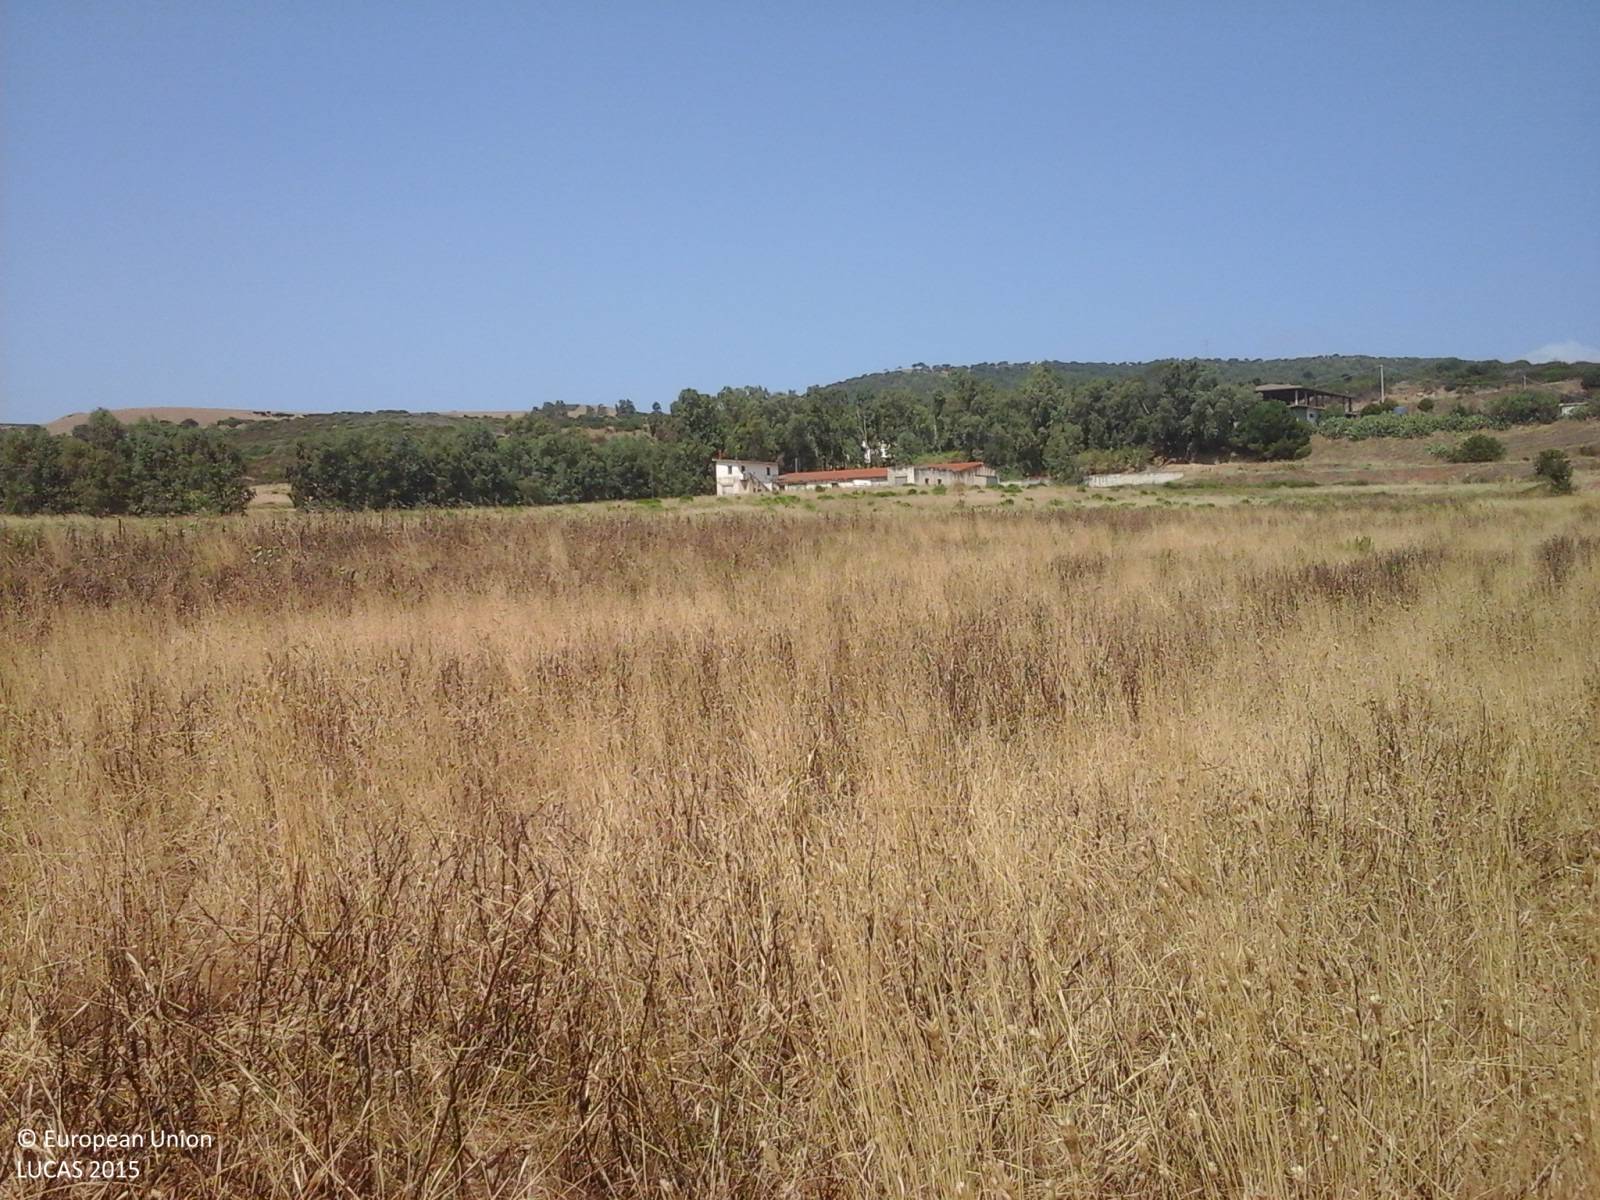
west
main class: Grassland
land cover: Grassland without tree/shrub cover
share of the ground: > 75 %
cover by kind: herbaceous plants 90 %, shrubs 5 %, unconsolidated bare surface 5 %
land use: Agriculture (excluding fallow land and kitchen gardens)
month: July
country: IT
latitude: 39.2786
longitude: 8.5598
